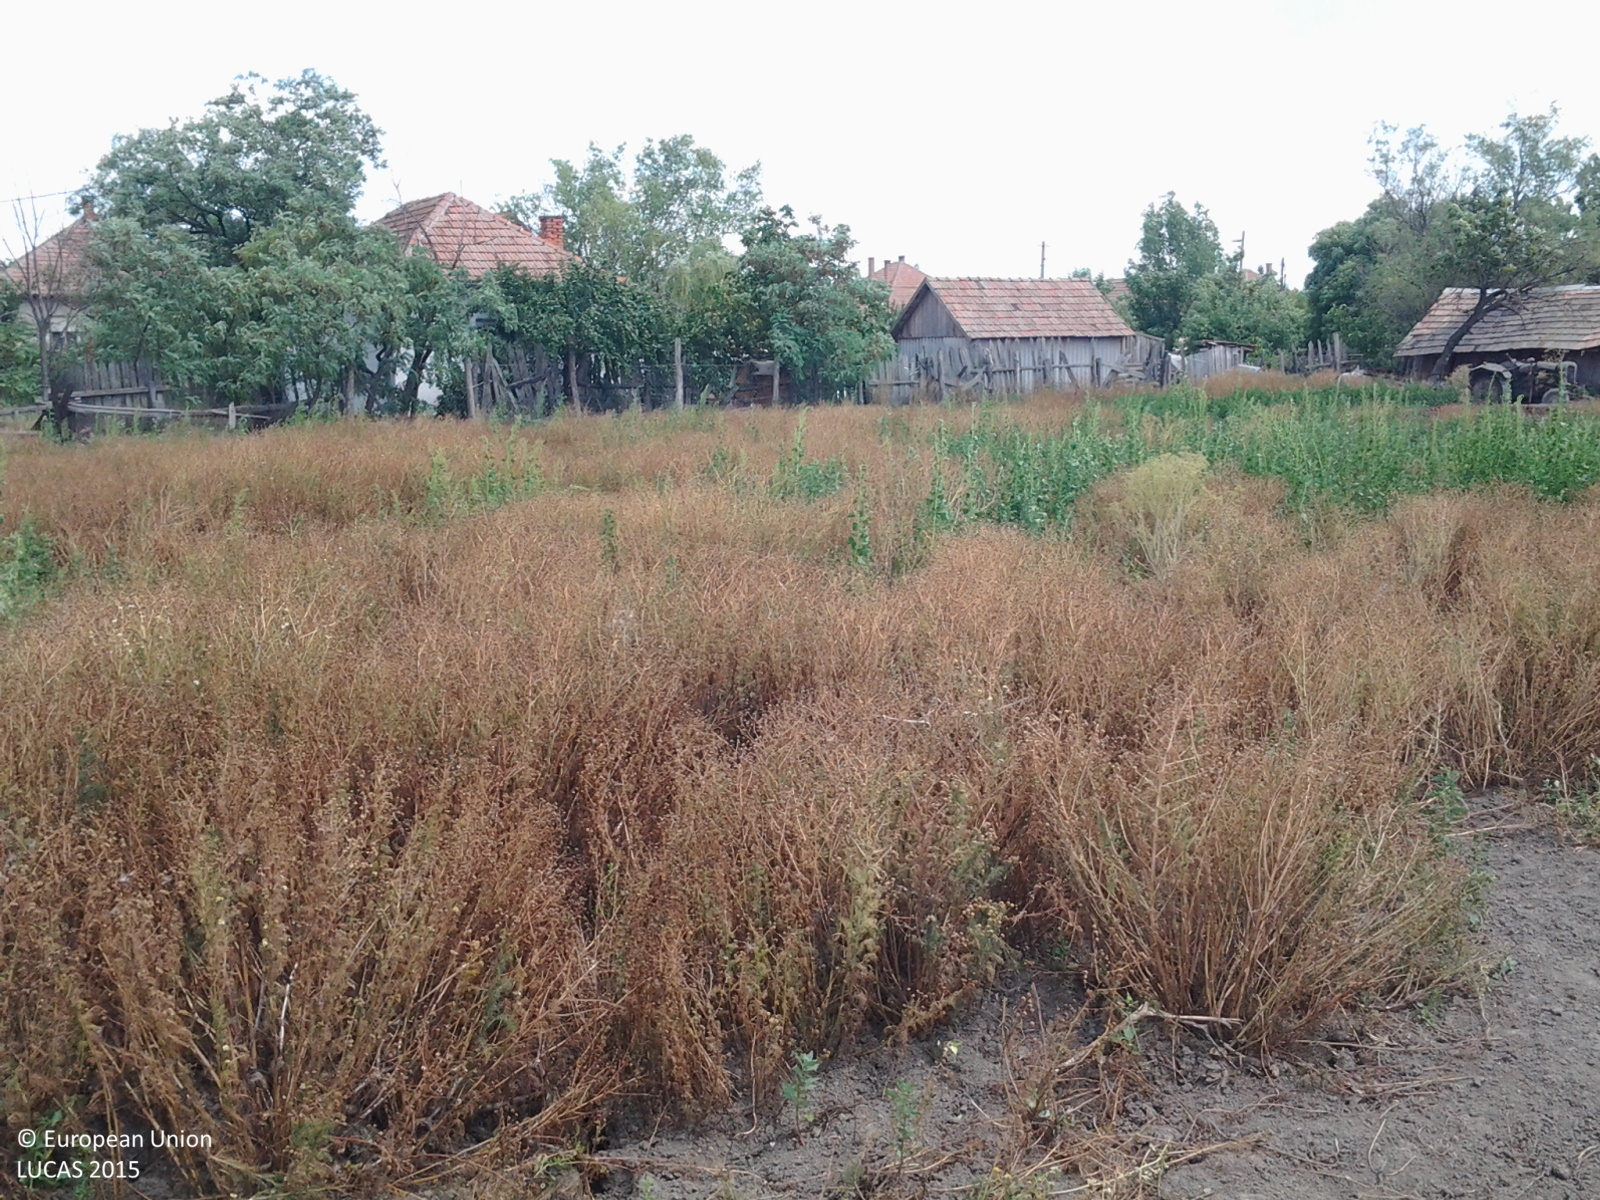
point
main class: Grassland
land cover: Spontaneously vegetated surfaces
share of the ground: > 75 %
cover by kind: herbaceous plants 95 %, unconsolidated bare surface 5 %
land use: Fallow land
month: July
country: HU
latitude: 47.2911
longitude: 20.2489
